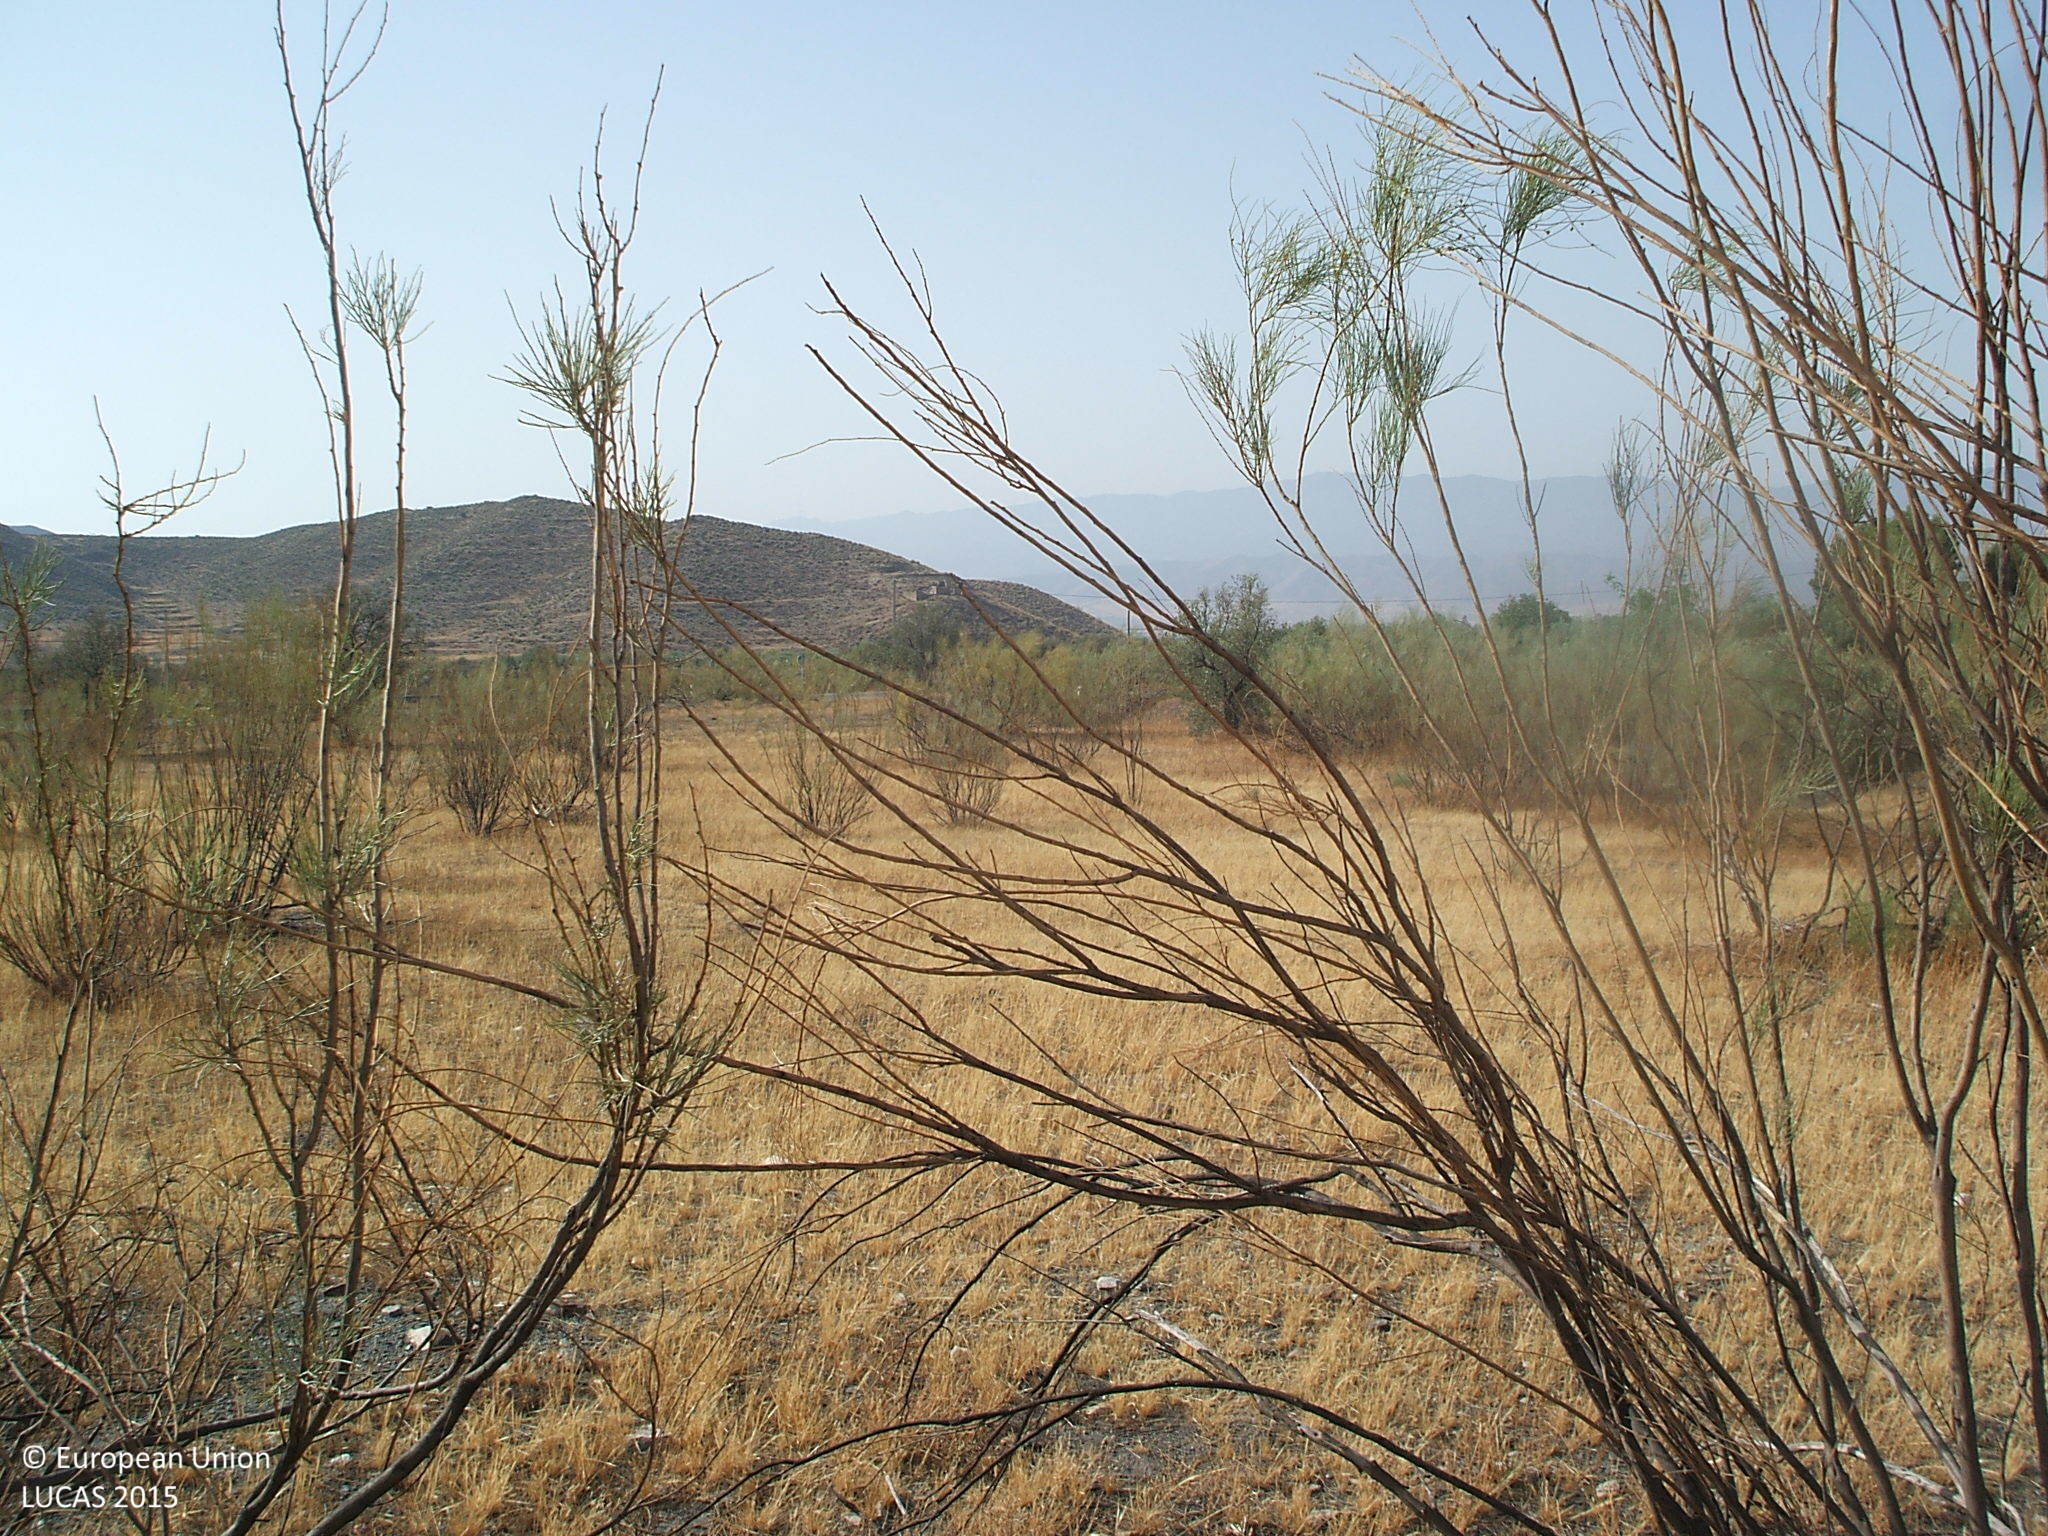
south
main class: Shrubland
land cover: Shrubland without tree cover
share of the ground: 10 - 25 %
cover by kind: herbaceous plants 85 %, shrubs 15 %
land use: Semi-natural and natural areas not in use
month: July
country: ES
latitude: 37.1227
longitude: -2.3481
